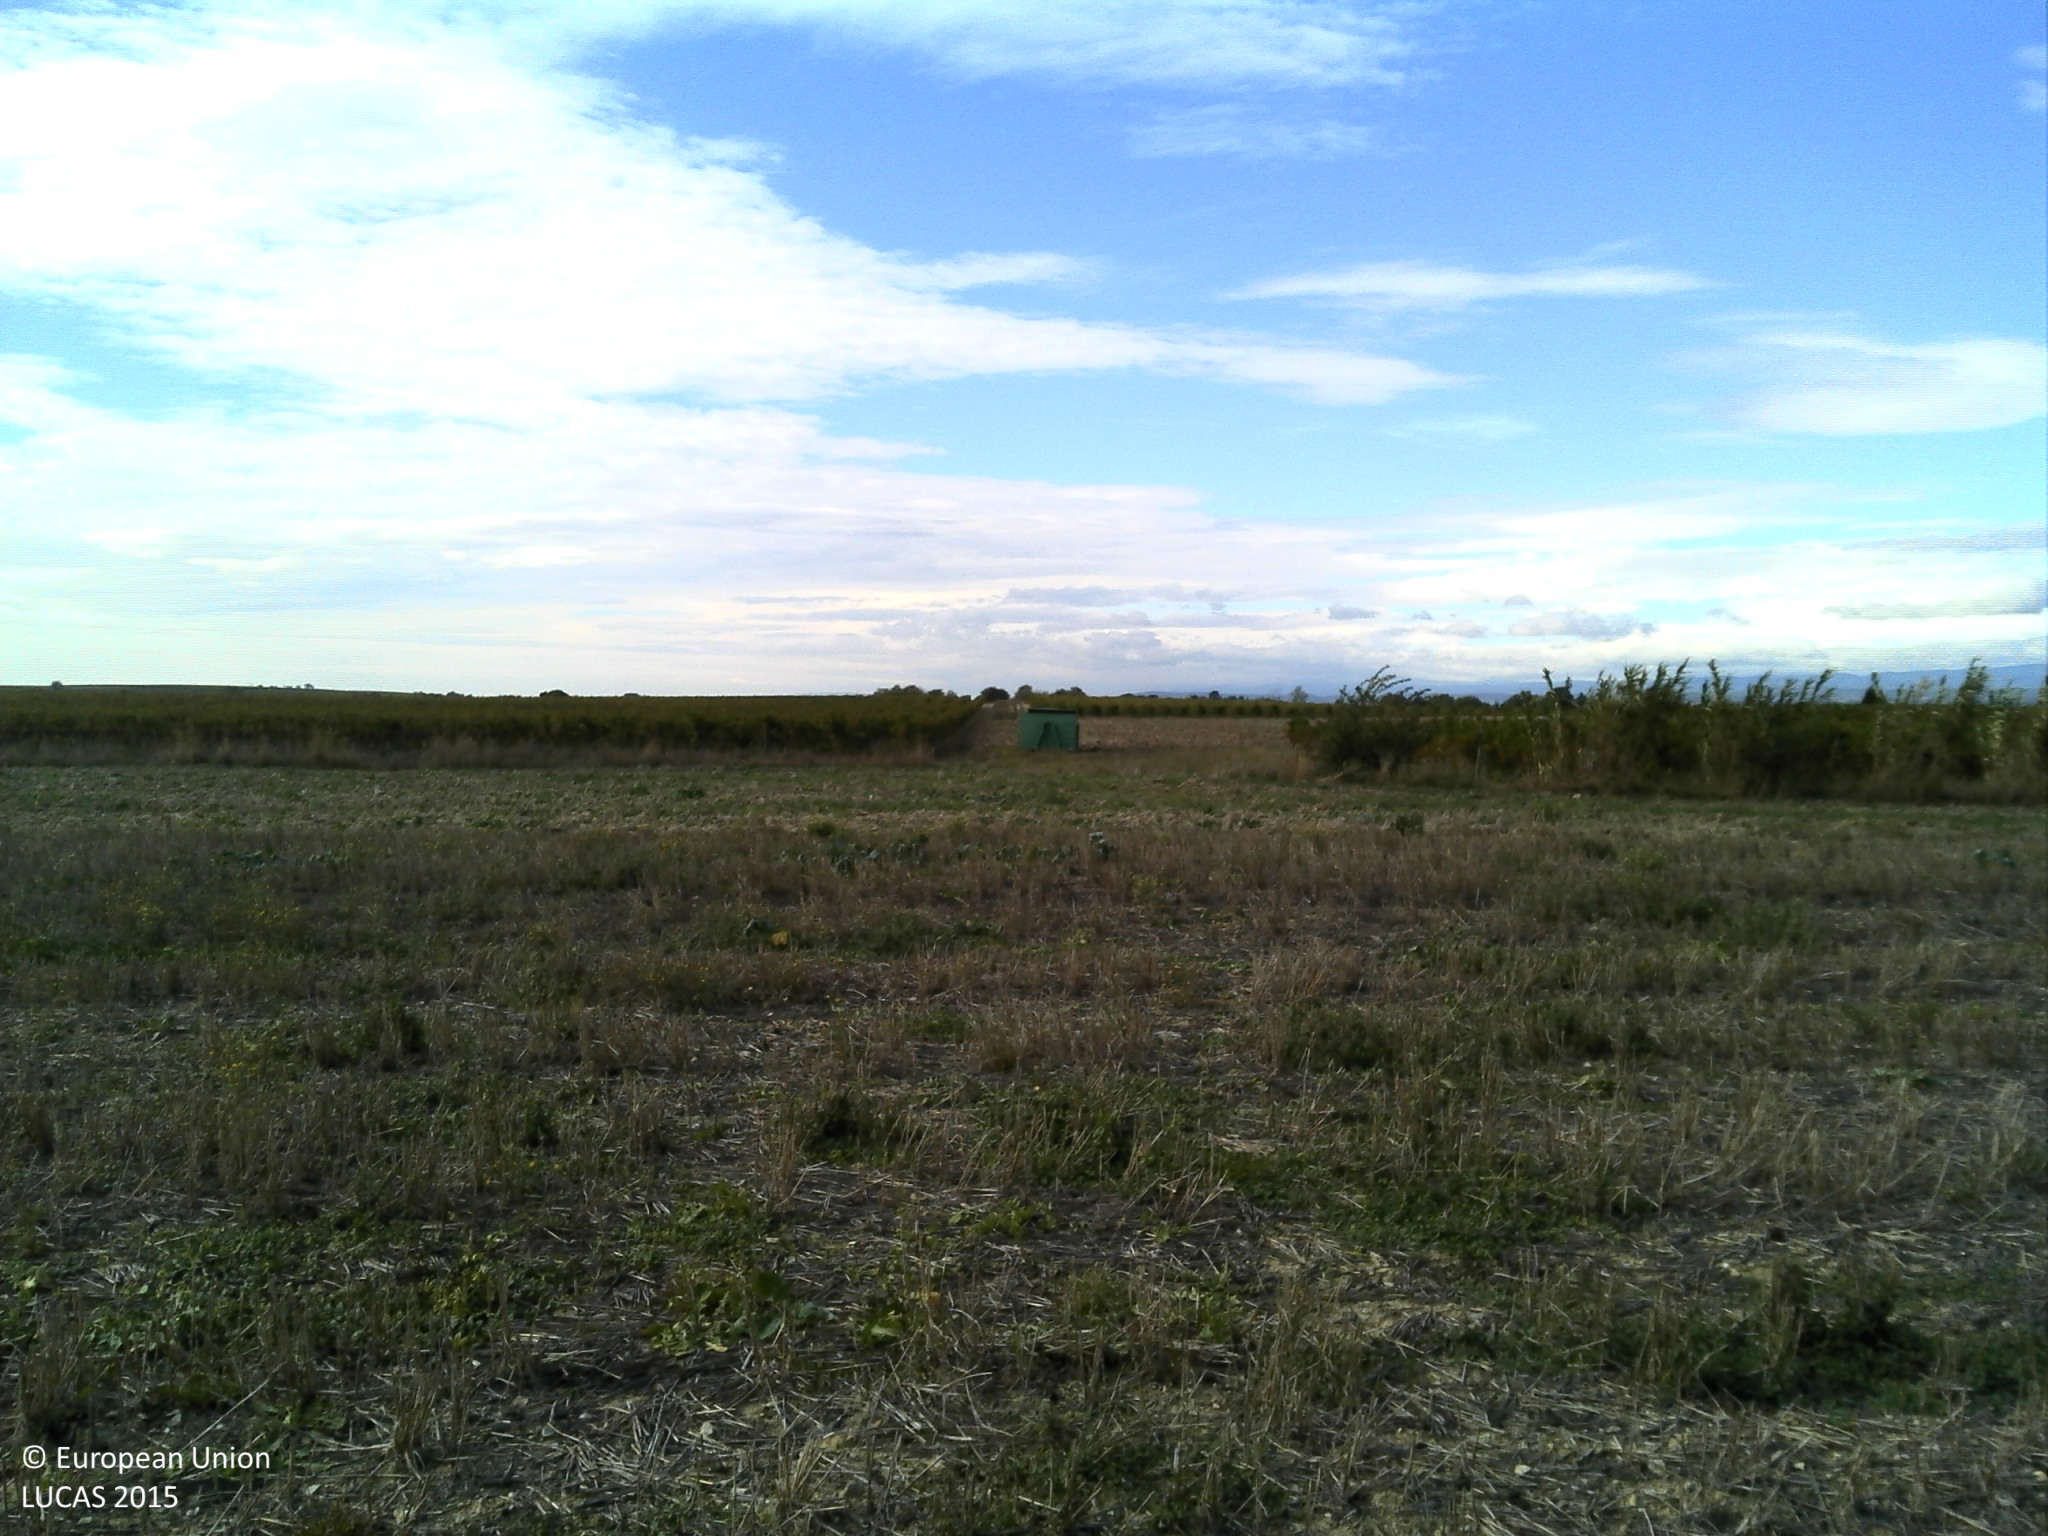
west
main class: Grassland
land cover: Spontaneously vegetated surfaces
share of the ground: 25 - 50 %
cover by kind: unconsolidated bare surface 70 %, herbaceous plants 30 %
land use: Agriculture (excluding fallow land and kitchen gardens)
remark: Harvested field
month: October
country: FR
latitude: 43.2877
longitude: 3.0955
